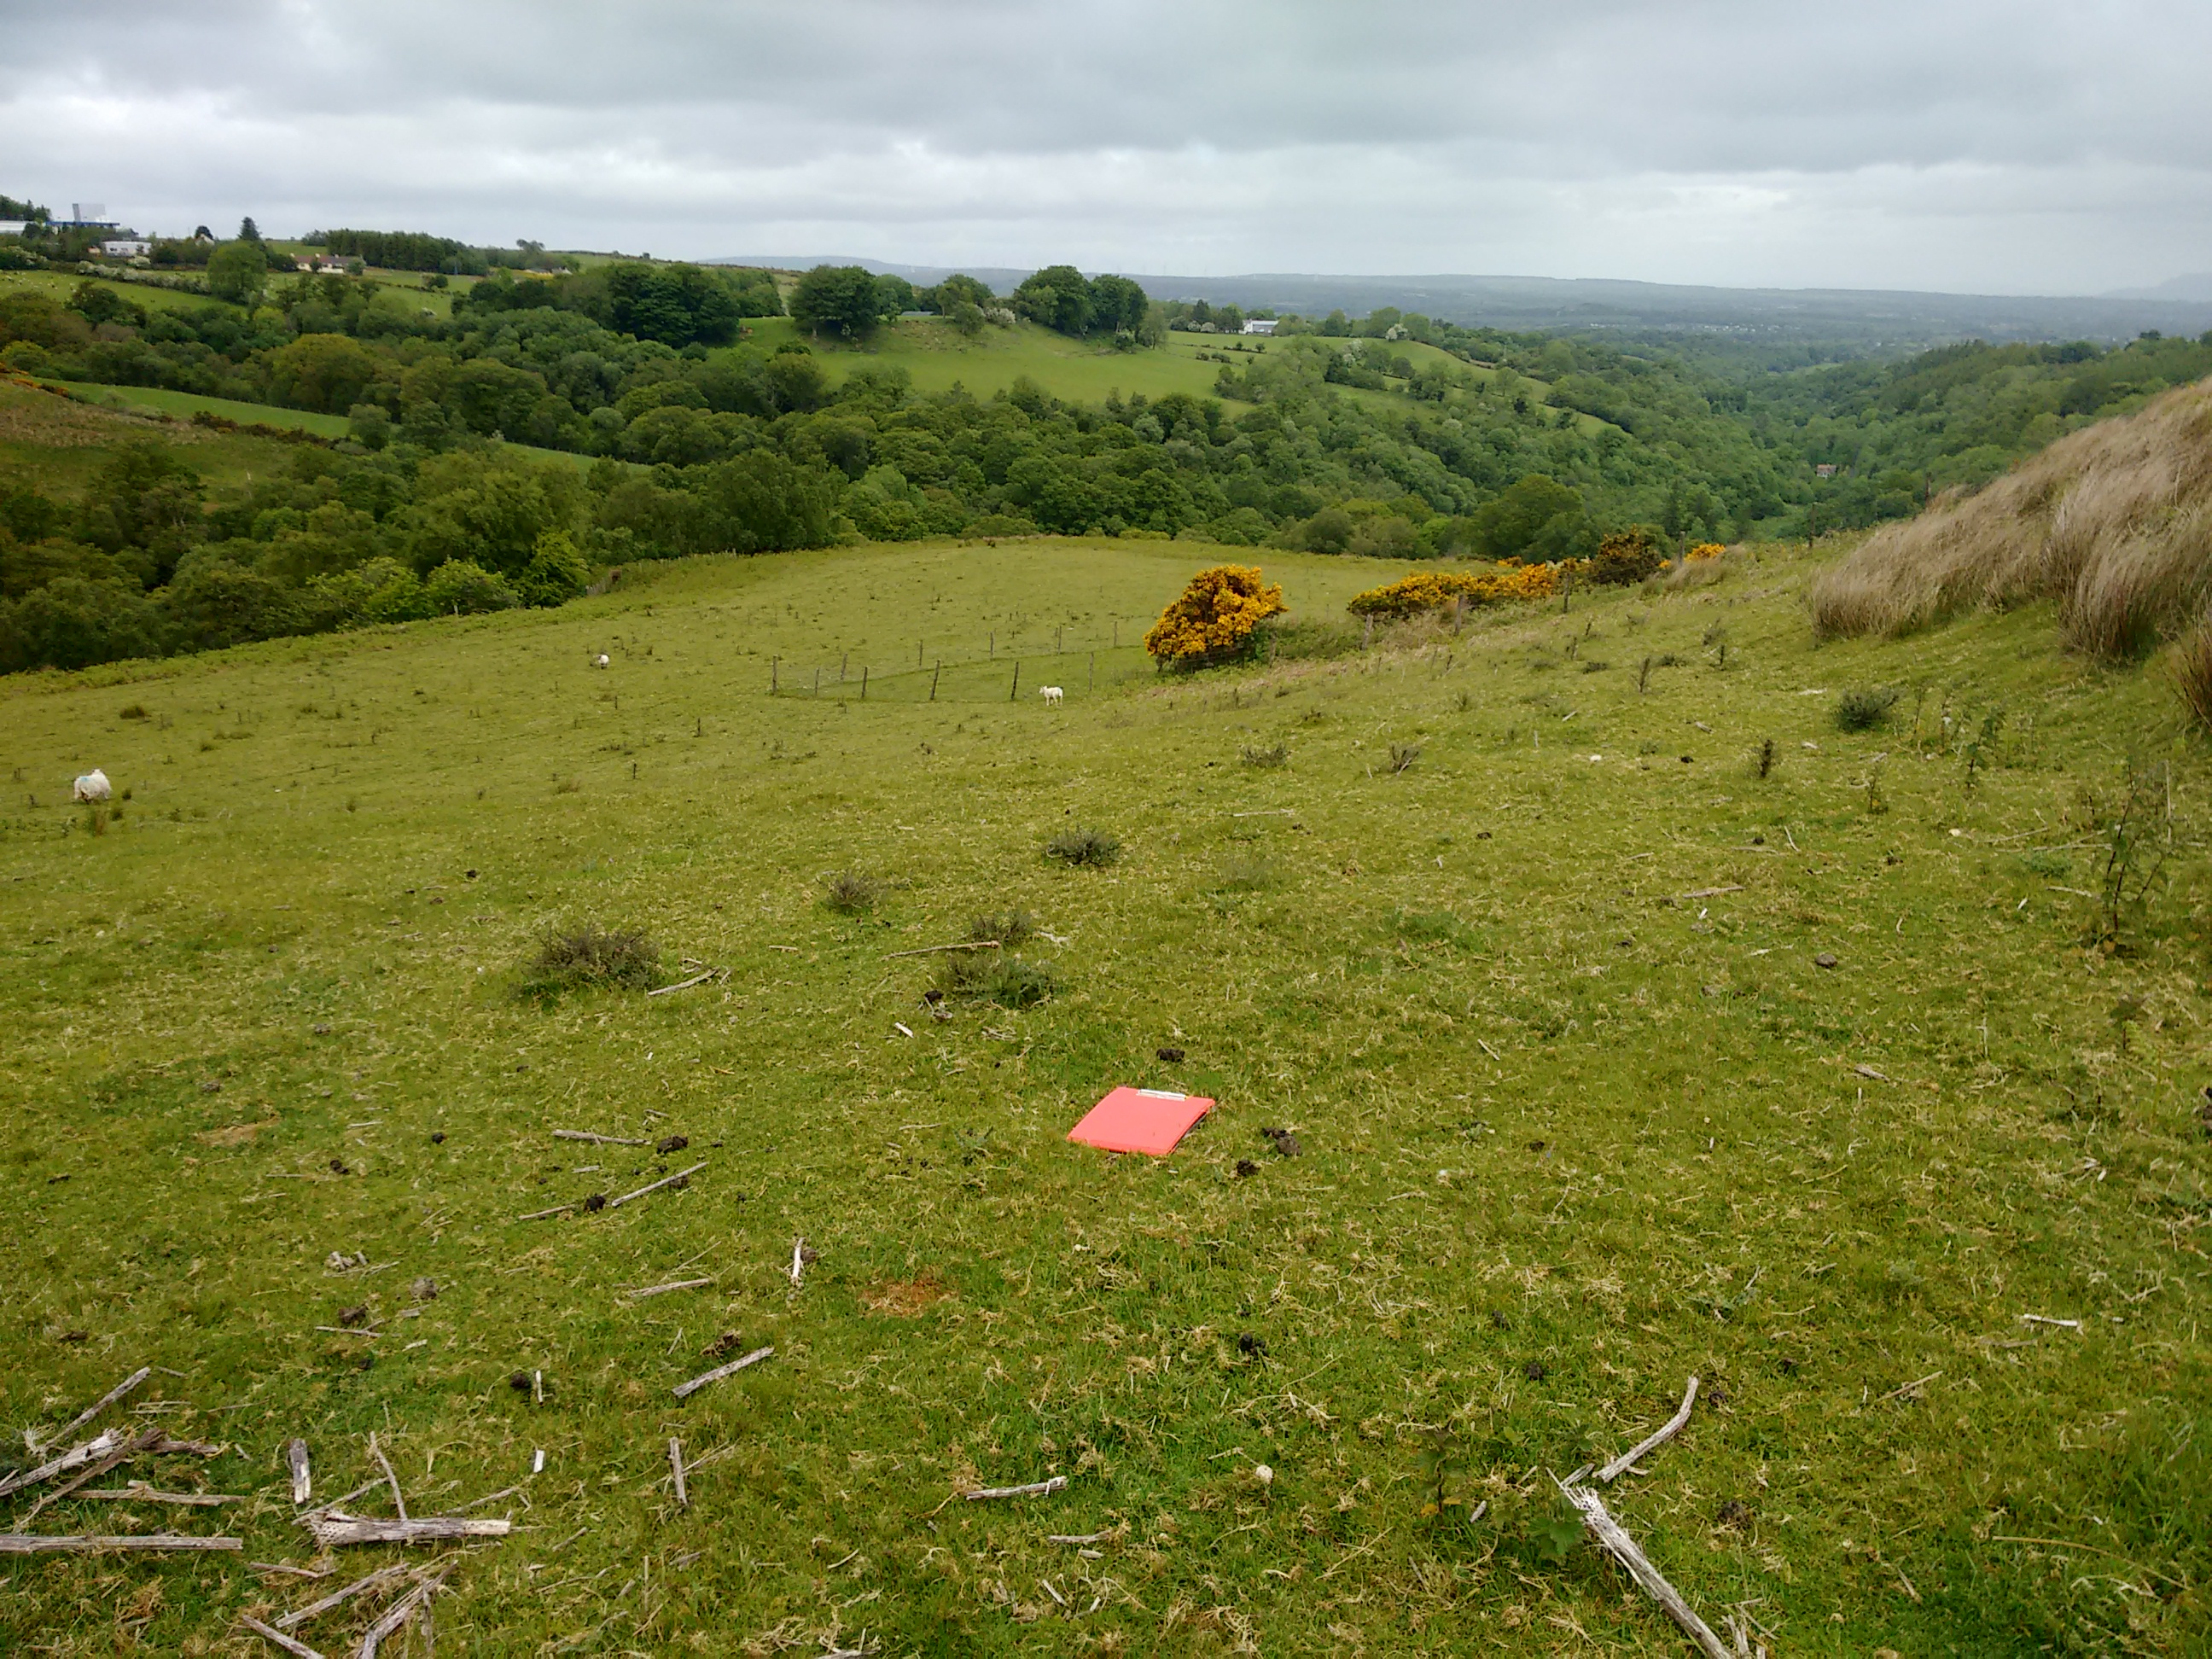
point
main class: Grassland
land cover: Grassland without tree/shrub cover
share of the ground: > 75 %
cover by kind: herbaceous plants 100 %
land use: Agriculture (excluding fallow land and kitchen gardens)
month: June
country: GB
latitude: 54.8808
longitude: -6.9550
